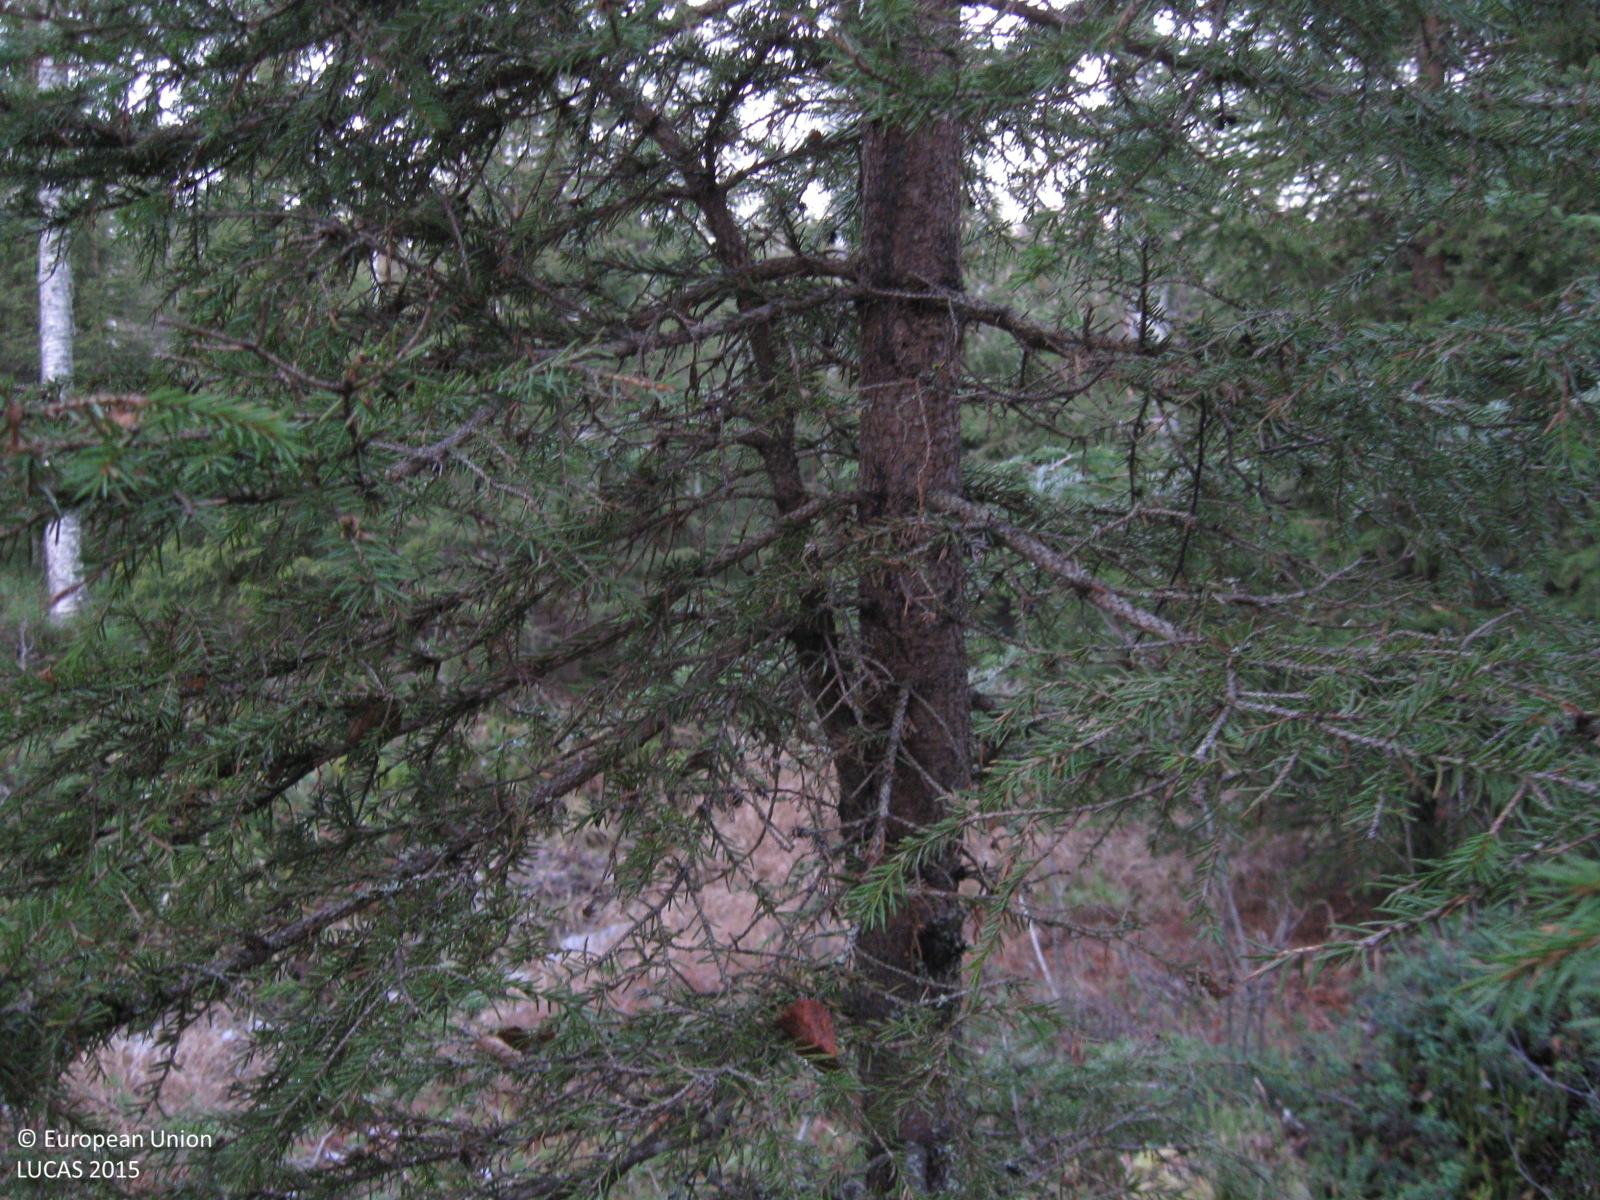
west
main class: Woodland
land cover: Spruce dominated mixed woodland
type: boreal forest
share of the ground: 50 - 75 %
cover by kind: coniferous forest trees 50 %, broadleaved forest trees 20 %, shrubs 15 %, herbaceous plants 10 %, lichens and mosses 5 %
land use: Forestry
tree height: > 5 m
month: November
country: SE
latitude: 66.1272
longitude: 20.5675
